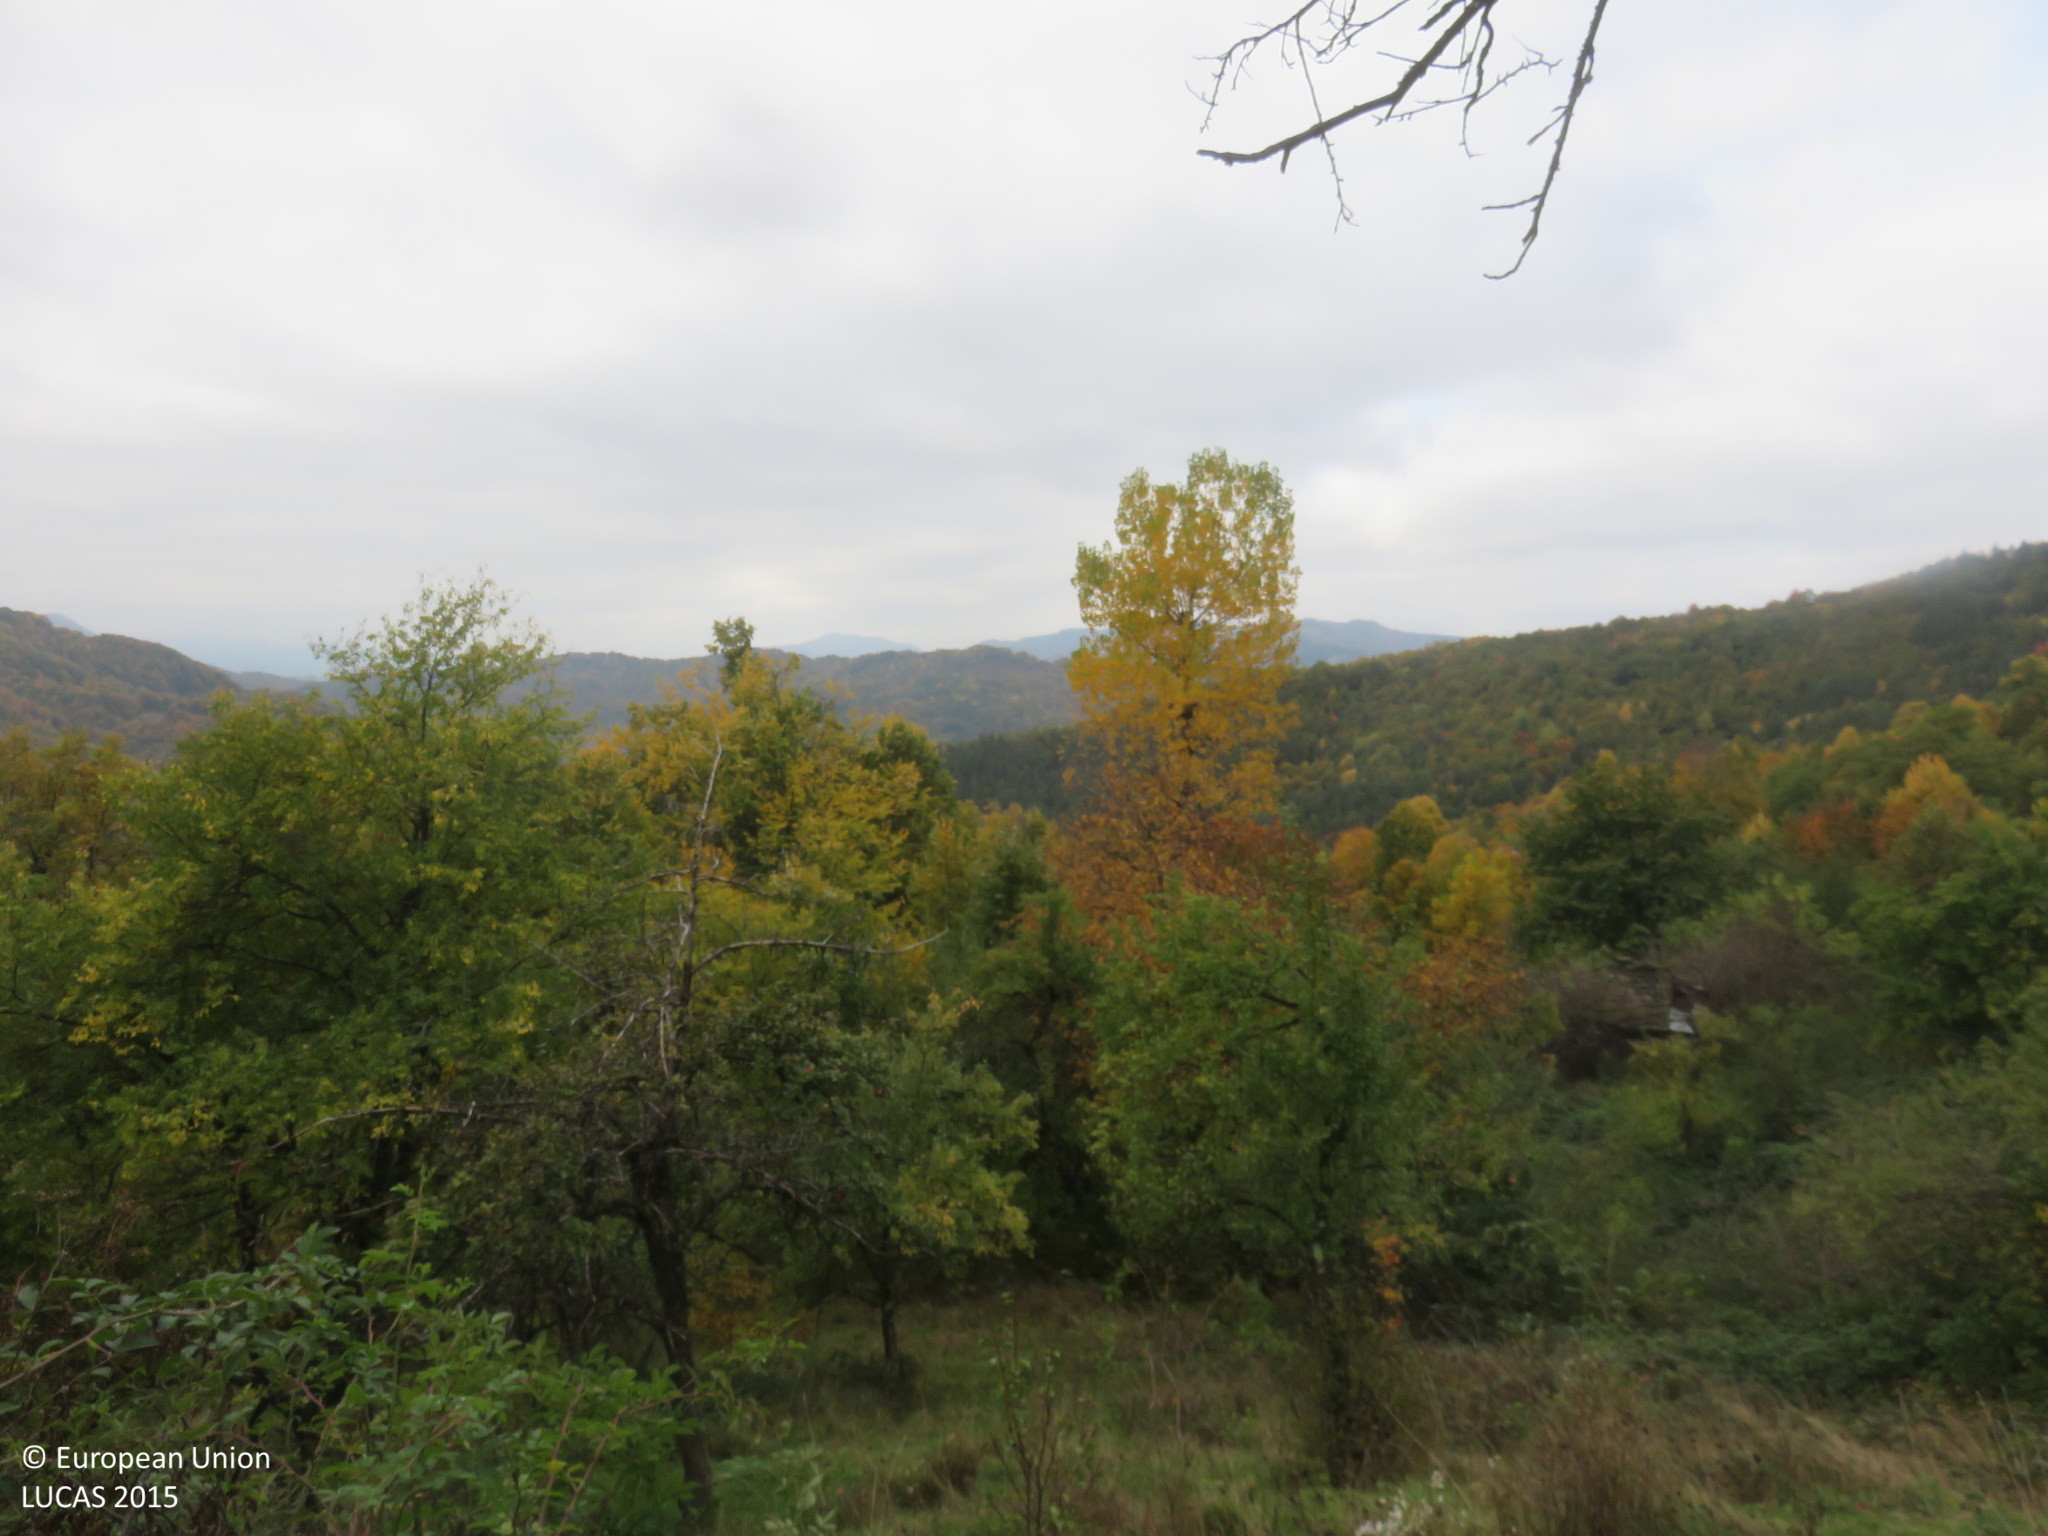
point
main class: Woodland
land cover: Pine dominated mixed woodland
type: hemiboreal forest and nemoral coniferous forest and mixed broadleaved-coniferous forest
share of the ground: > 75 %
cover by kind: coniferous forest trees 75 %, broadleaved forest trees 25 %
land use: Forestry
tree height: > 5 m
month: October
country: BG
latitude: 42.8345
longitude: 25.1015
